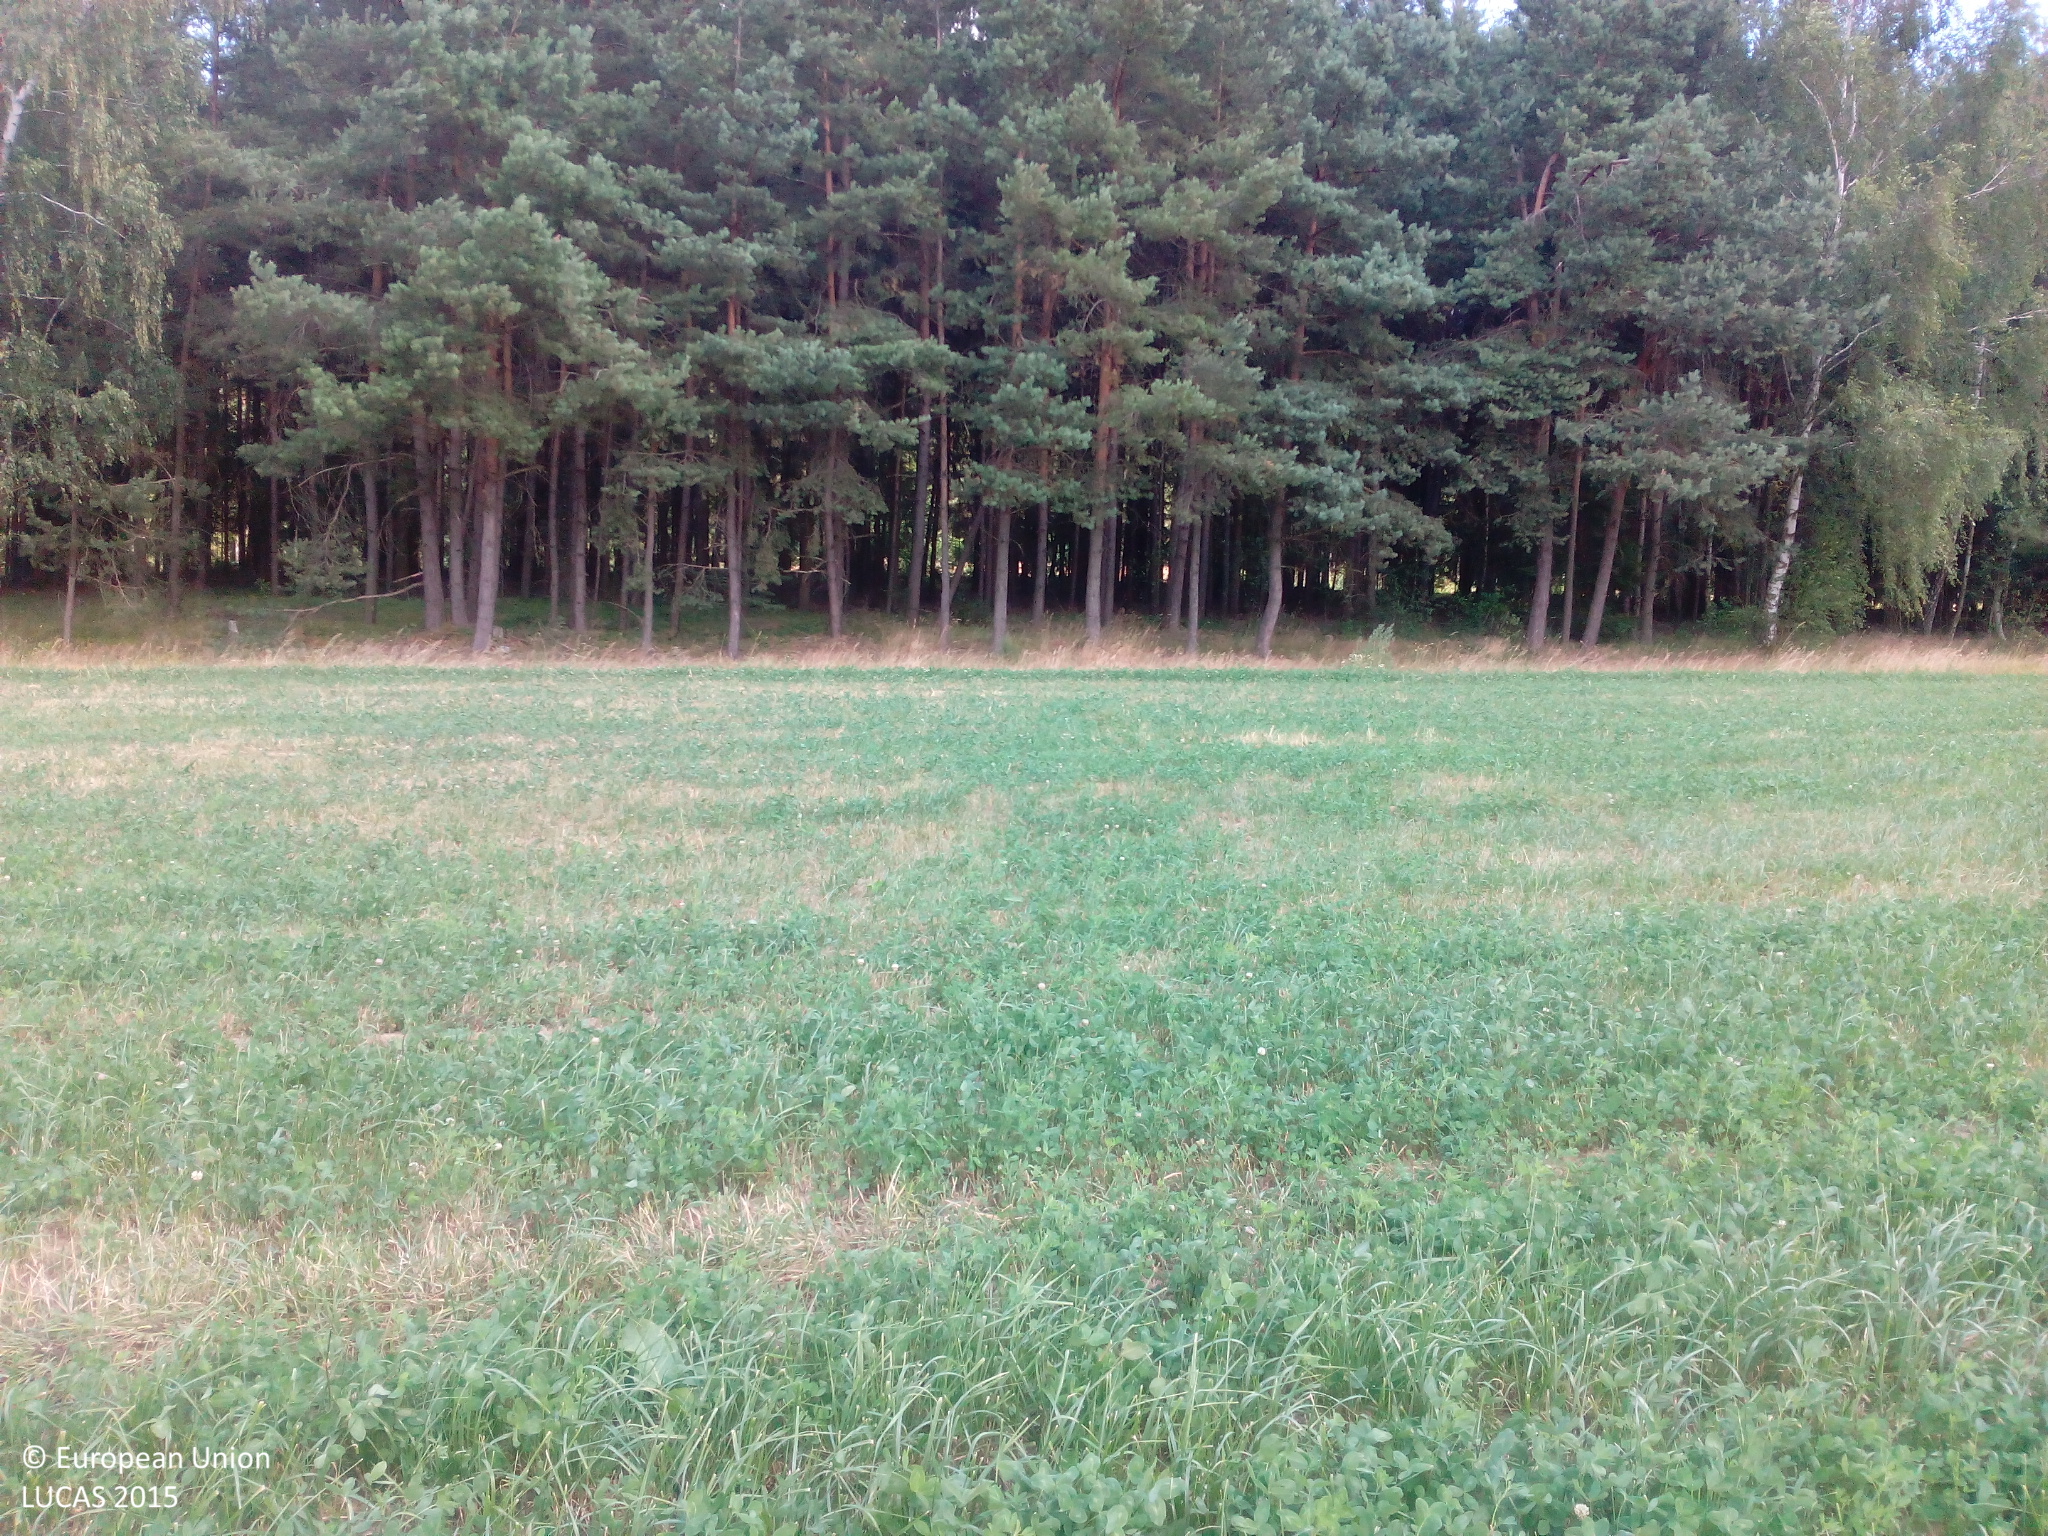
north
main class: Cropland
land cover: Other leguminous and mixtures for fodder
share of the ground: > 75 %
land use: Agriculture (excluding fallow land and kitchen gardens)
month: July
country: DE
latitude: 49.5329
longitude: 12.2241
